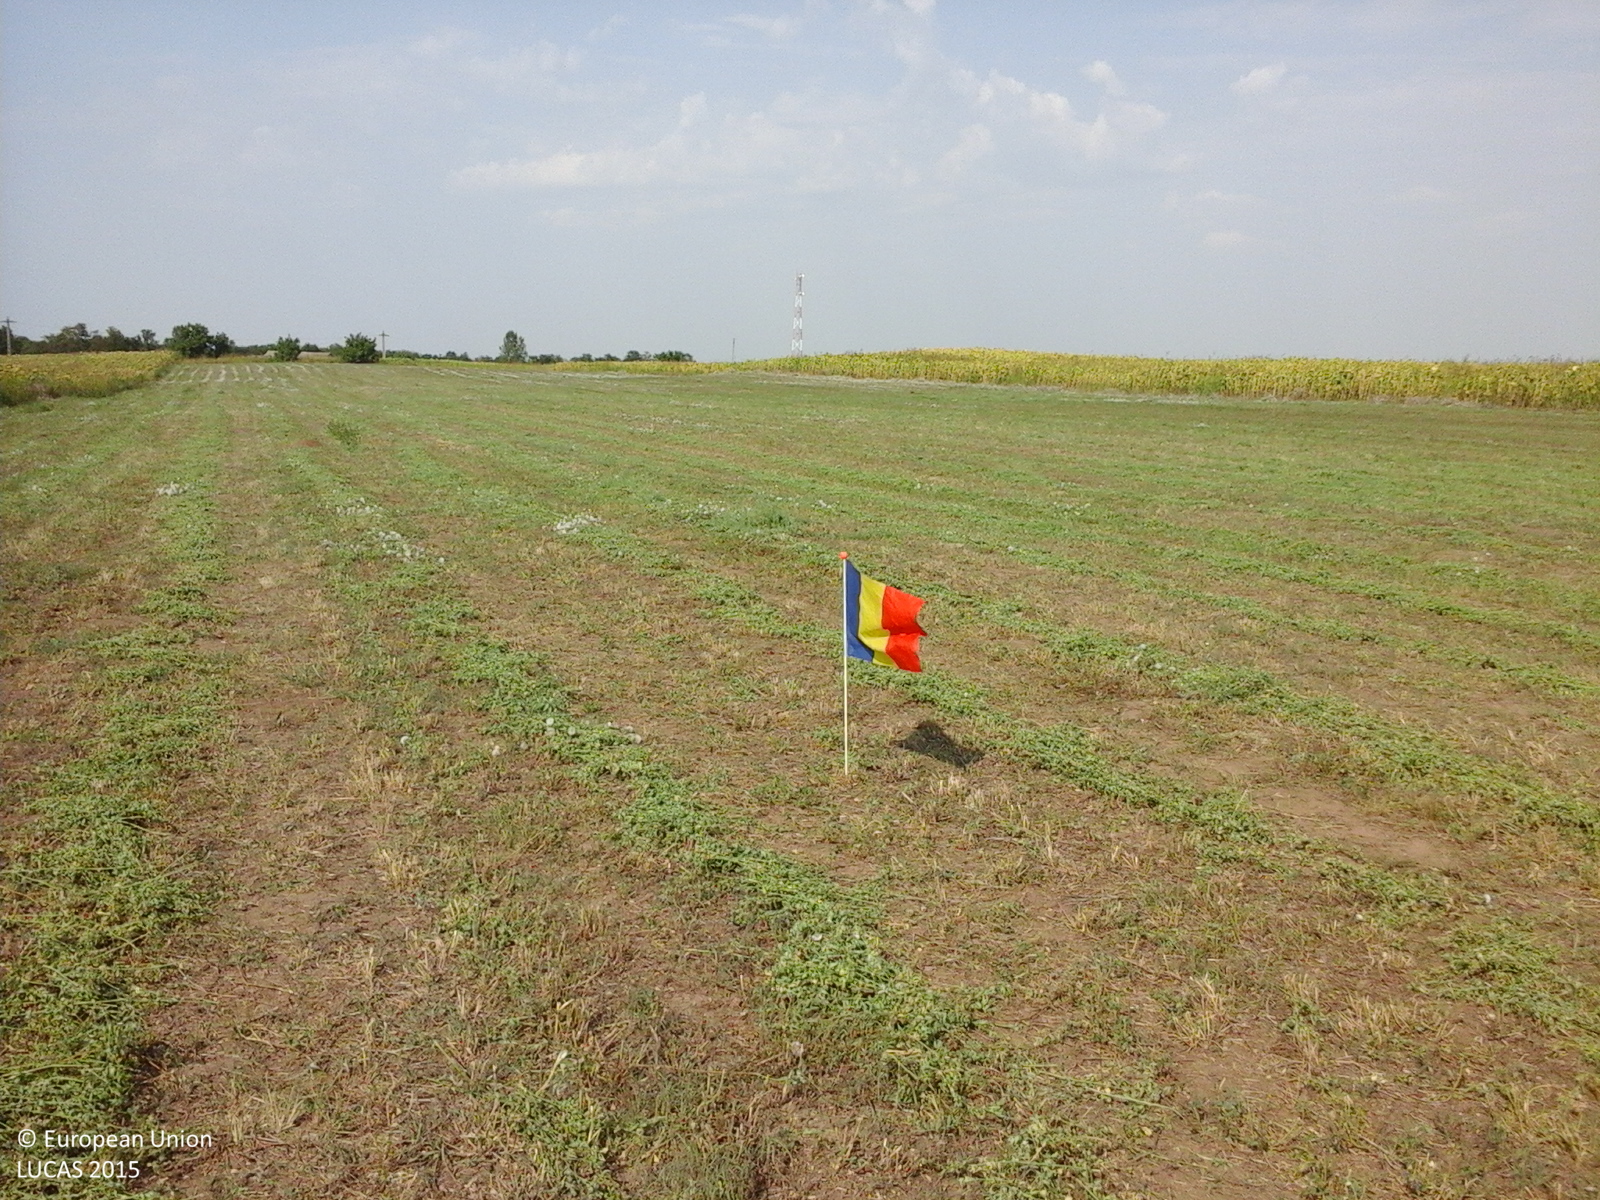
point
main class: Cropland
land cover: Lucerne
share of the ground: 50 - 75 %
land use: Agriculture (excluding fallow land and kitchen gardens)
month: August
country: RO
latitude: 45.2846
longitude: 27.4767
